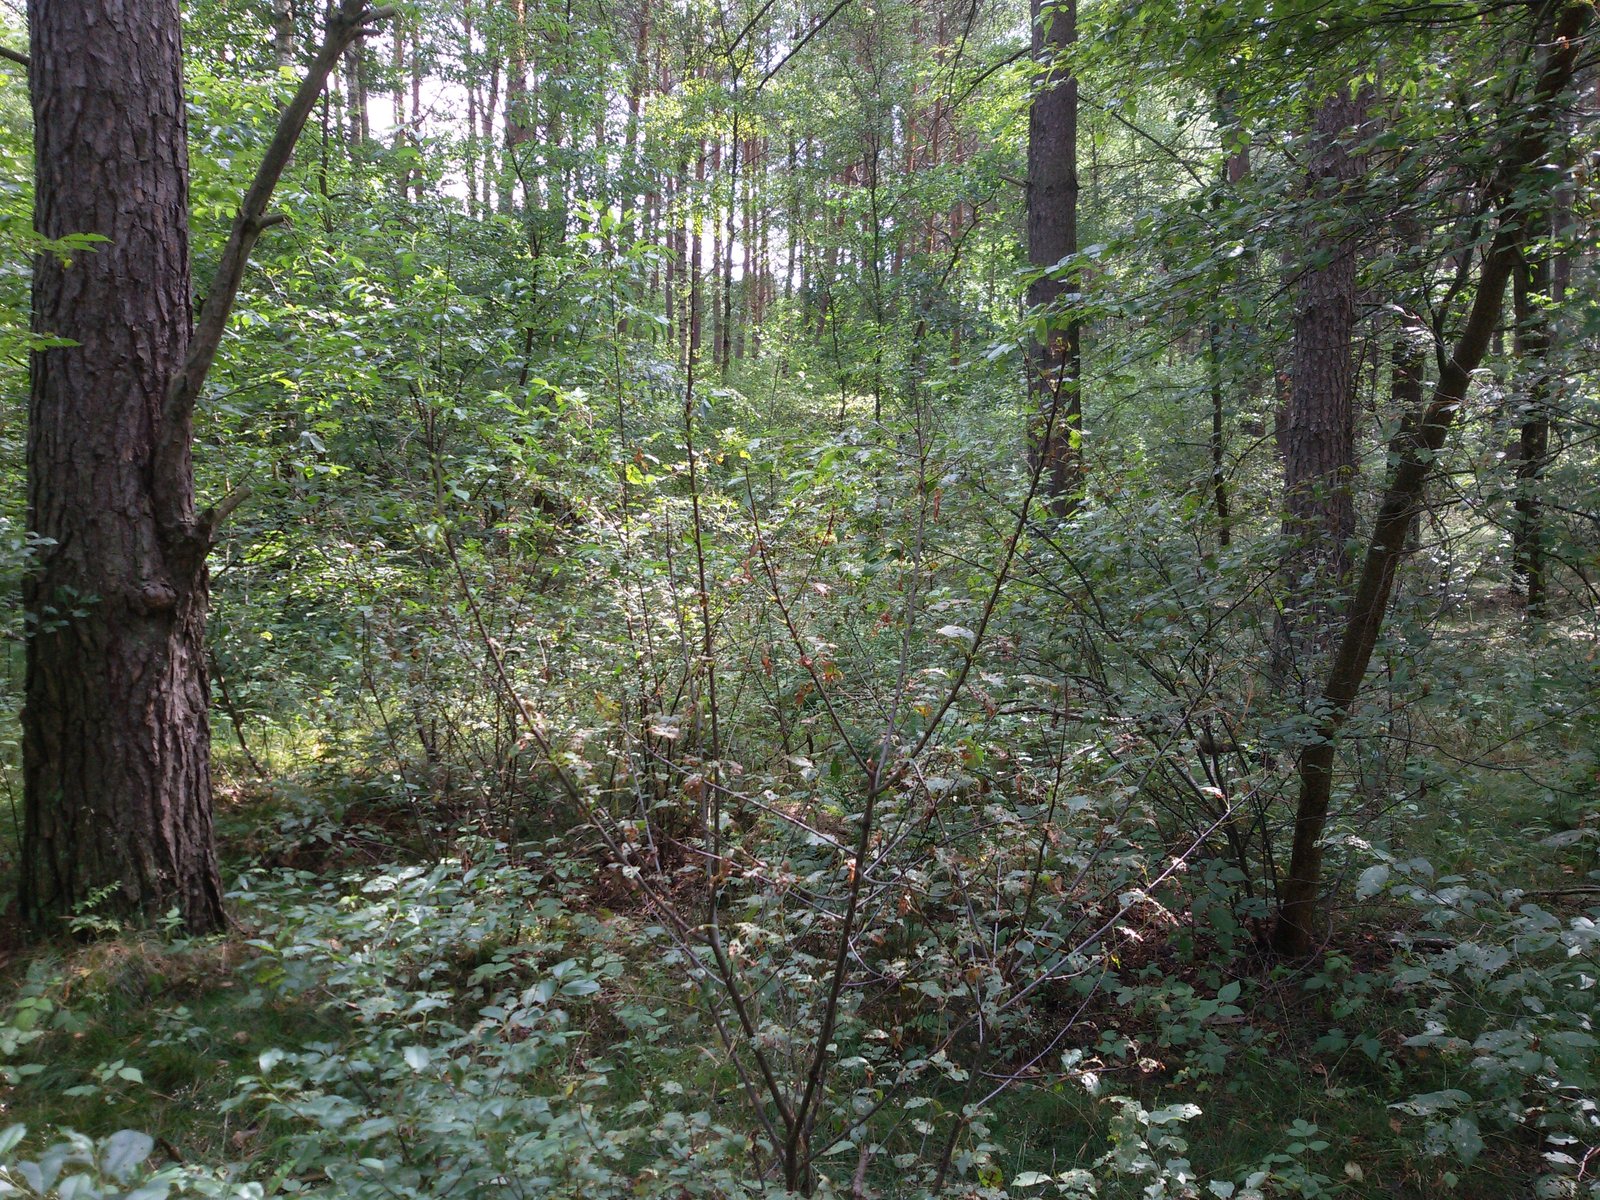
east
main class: Woodland
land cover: Pine dominated mixed woodland
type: hemiboreal forest and nemoral coniferous forest and mixed broadleaved-coniferous forest
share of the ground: > 75 %
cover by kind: coniferous forest trees 60 %, broadleaved forest trees 20 %, shrubs 10 %, herbaceous plants 10 %
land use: Forestry
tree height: > 5 m
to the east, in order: Pine dominated mixed woodland; Broadleaved woodland; Ditches and canals; Broadleaved woodland
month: July
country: PL
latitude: 52.6397
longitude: 17.5939
